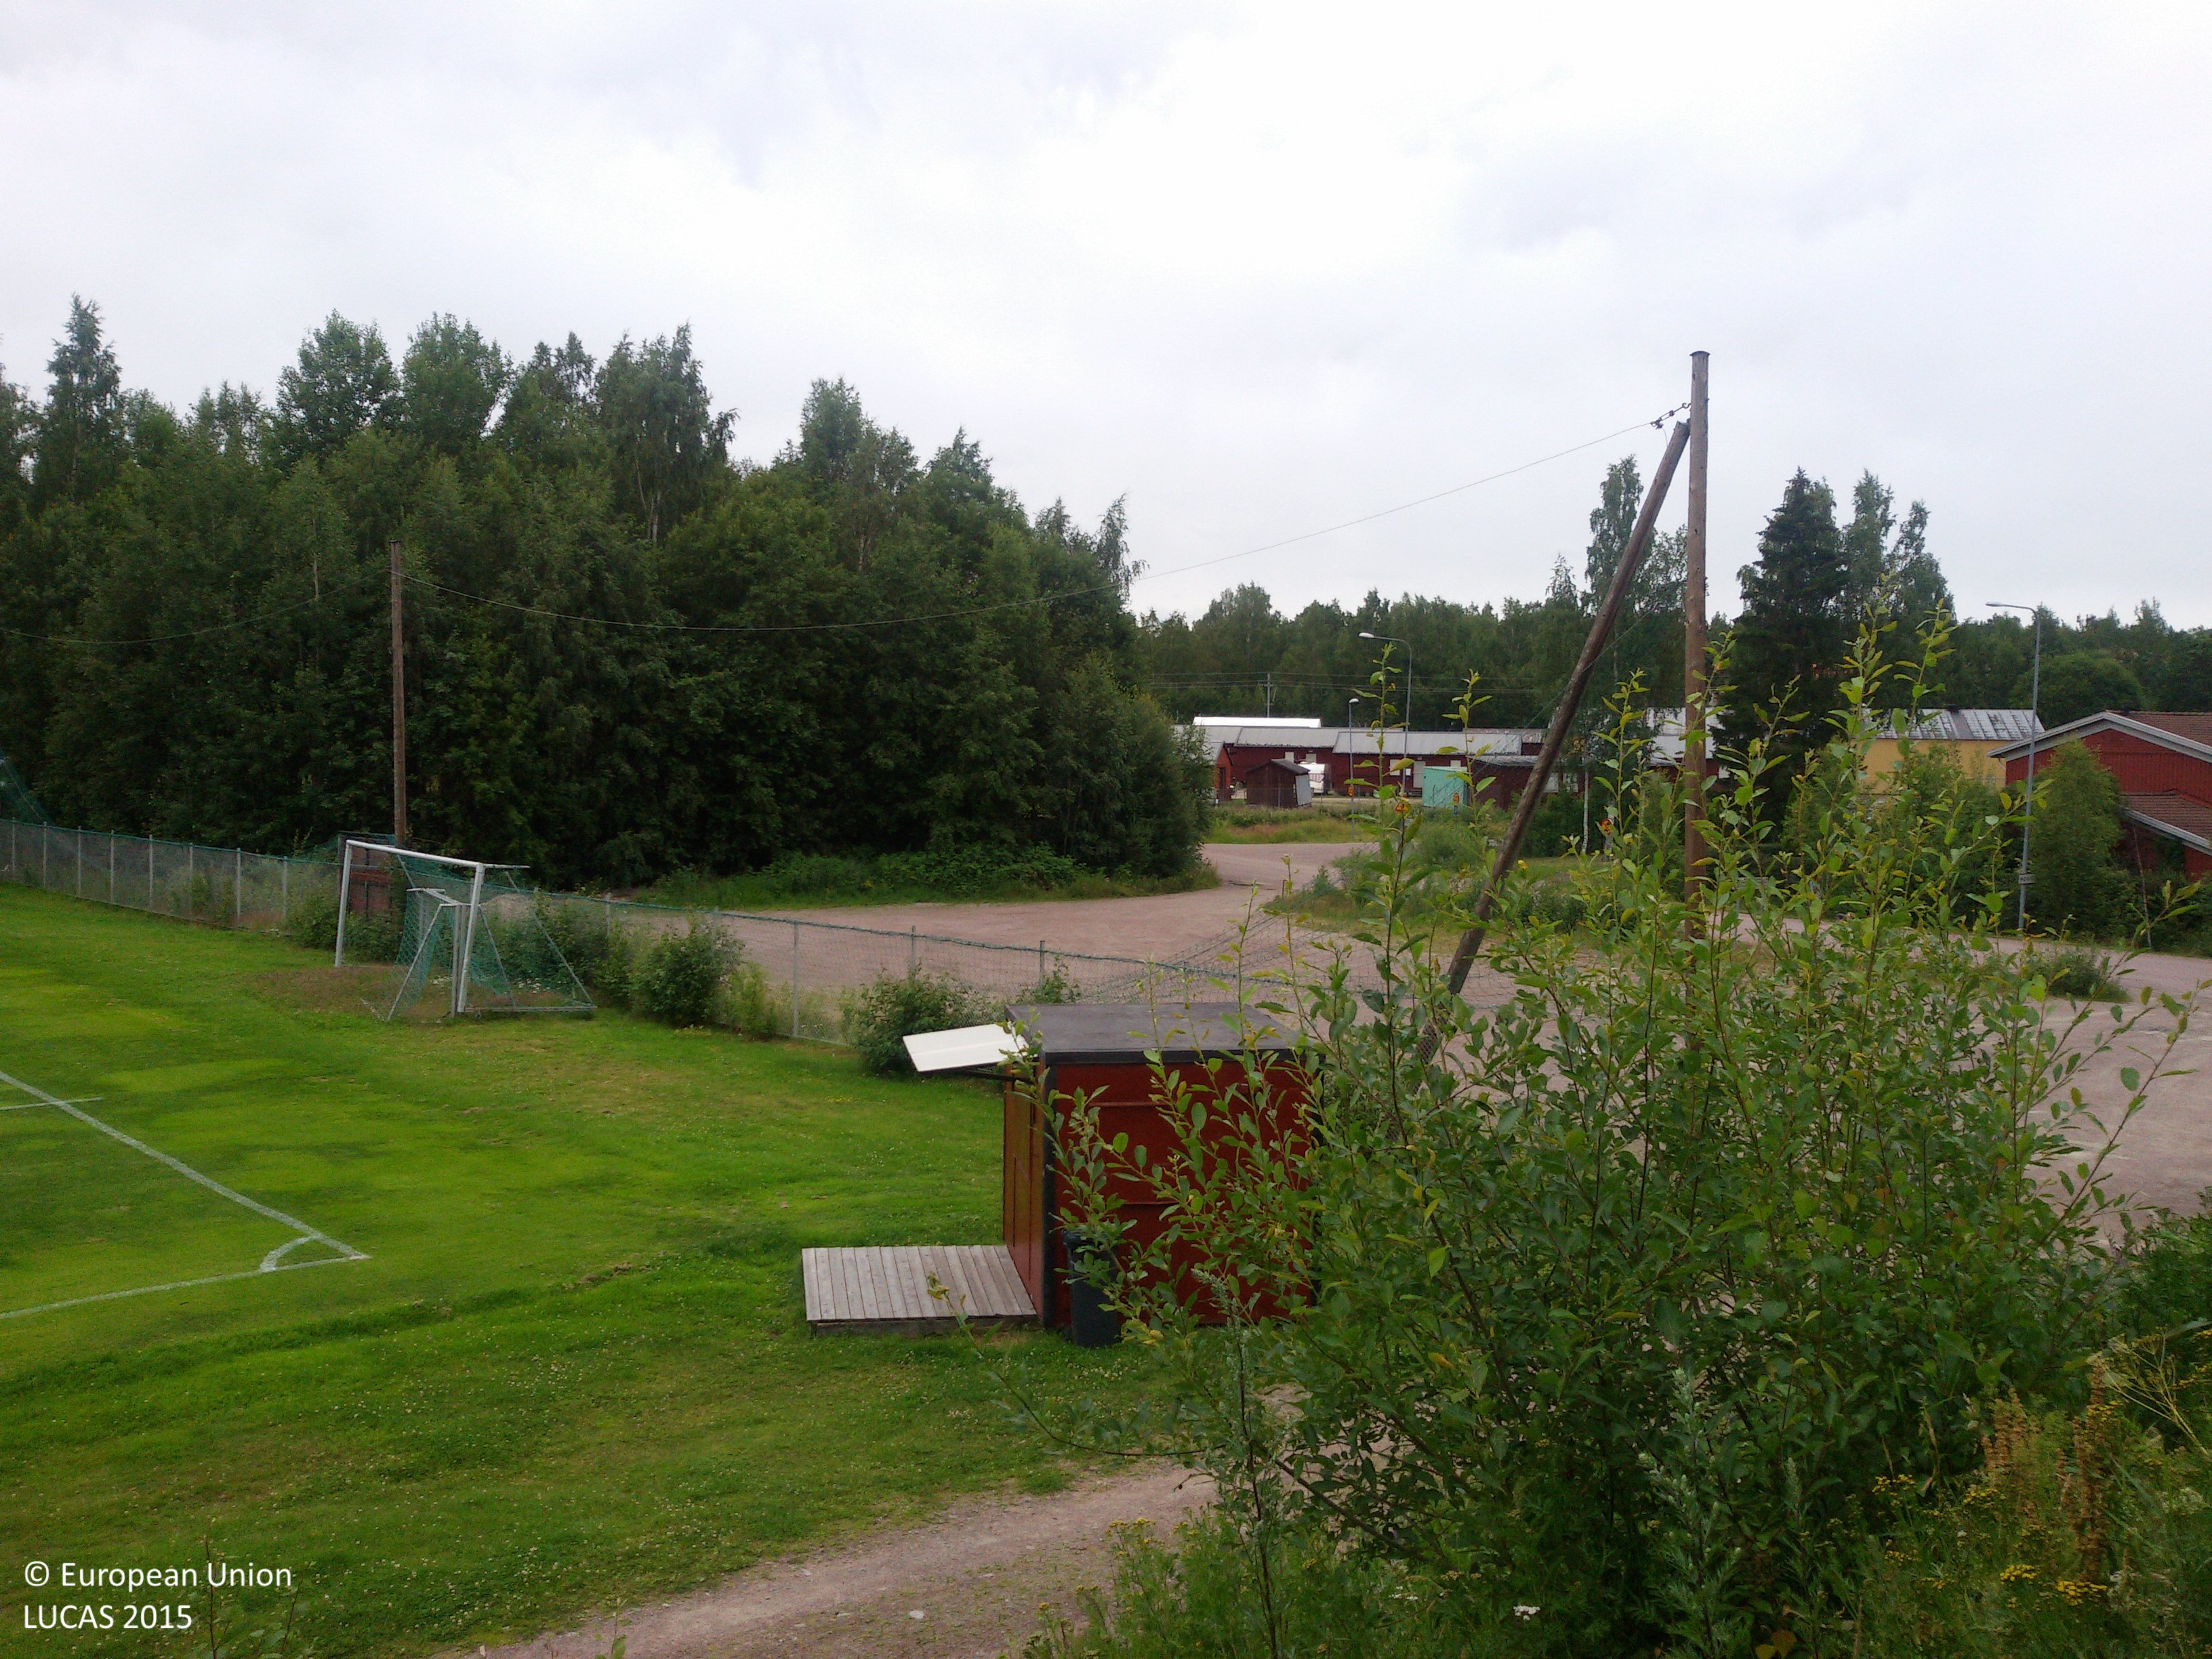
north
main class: Woodland
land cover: Broadleaved woodland
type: boreal forest
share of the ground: > 75 %
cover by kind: broadleaved forest trees 100 %
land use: Semi-natural and natural areas not in use
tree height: > 5 m
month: July
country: SE
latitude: 60.5876
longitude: 15.7377
